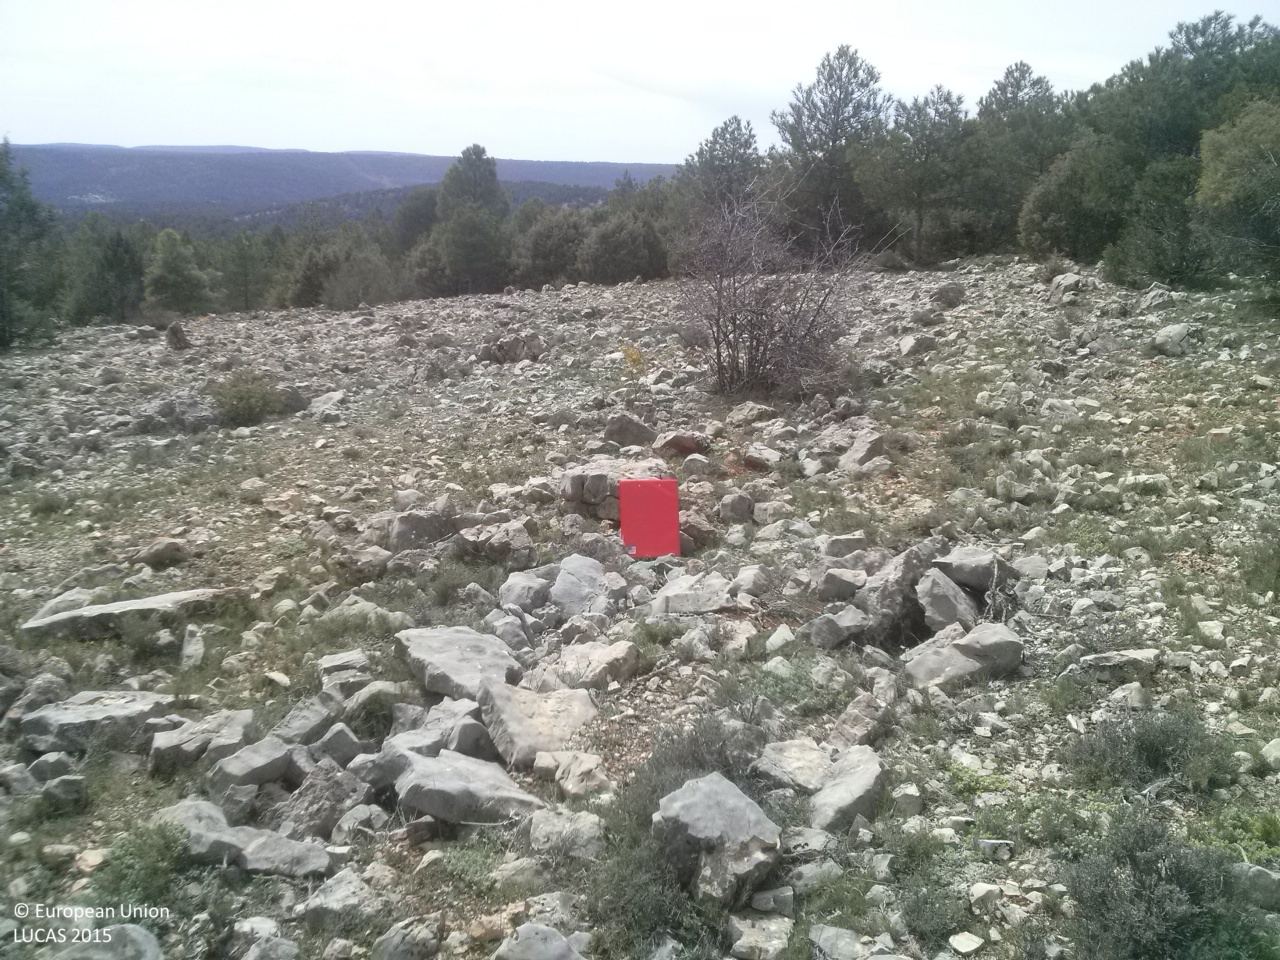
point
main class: Grassland
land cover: Grassland with sparse tree/shrub cover
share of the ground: 50 - 75 %
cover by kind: consolidated bare surface 55 %, herbaceous plants 35 %, coniferous forest trees 5 %, shrubs 5 %
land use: Semi-natural and natural areas not in use
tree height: < 5 m
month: April
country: ES
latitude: 40.0561
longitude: -1.8651
